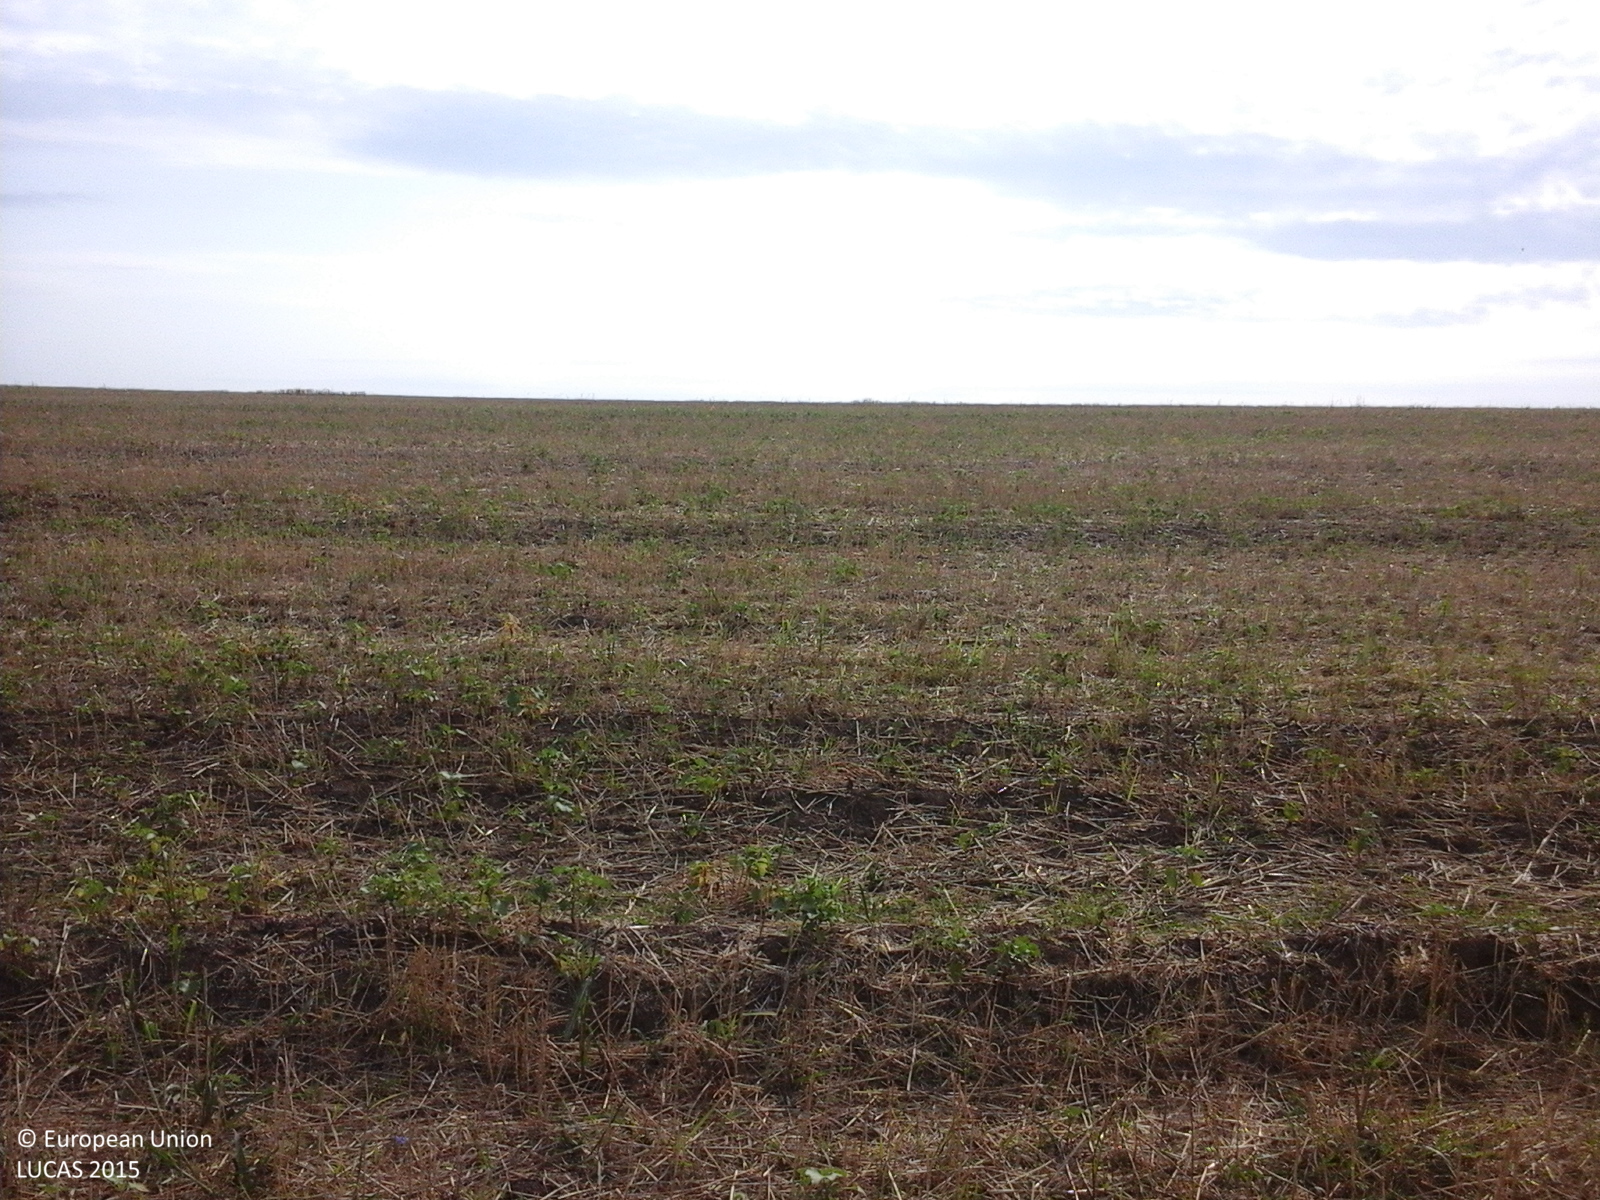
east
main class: Cropland
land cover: Sunflower
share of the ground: > 75 %
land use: Agriculture (excluding fallow land and kitchen gardens)
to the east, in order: Sunflower; Common wheat
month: August
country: RO
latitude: 44.0350
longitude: 27.6745
